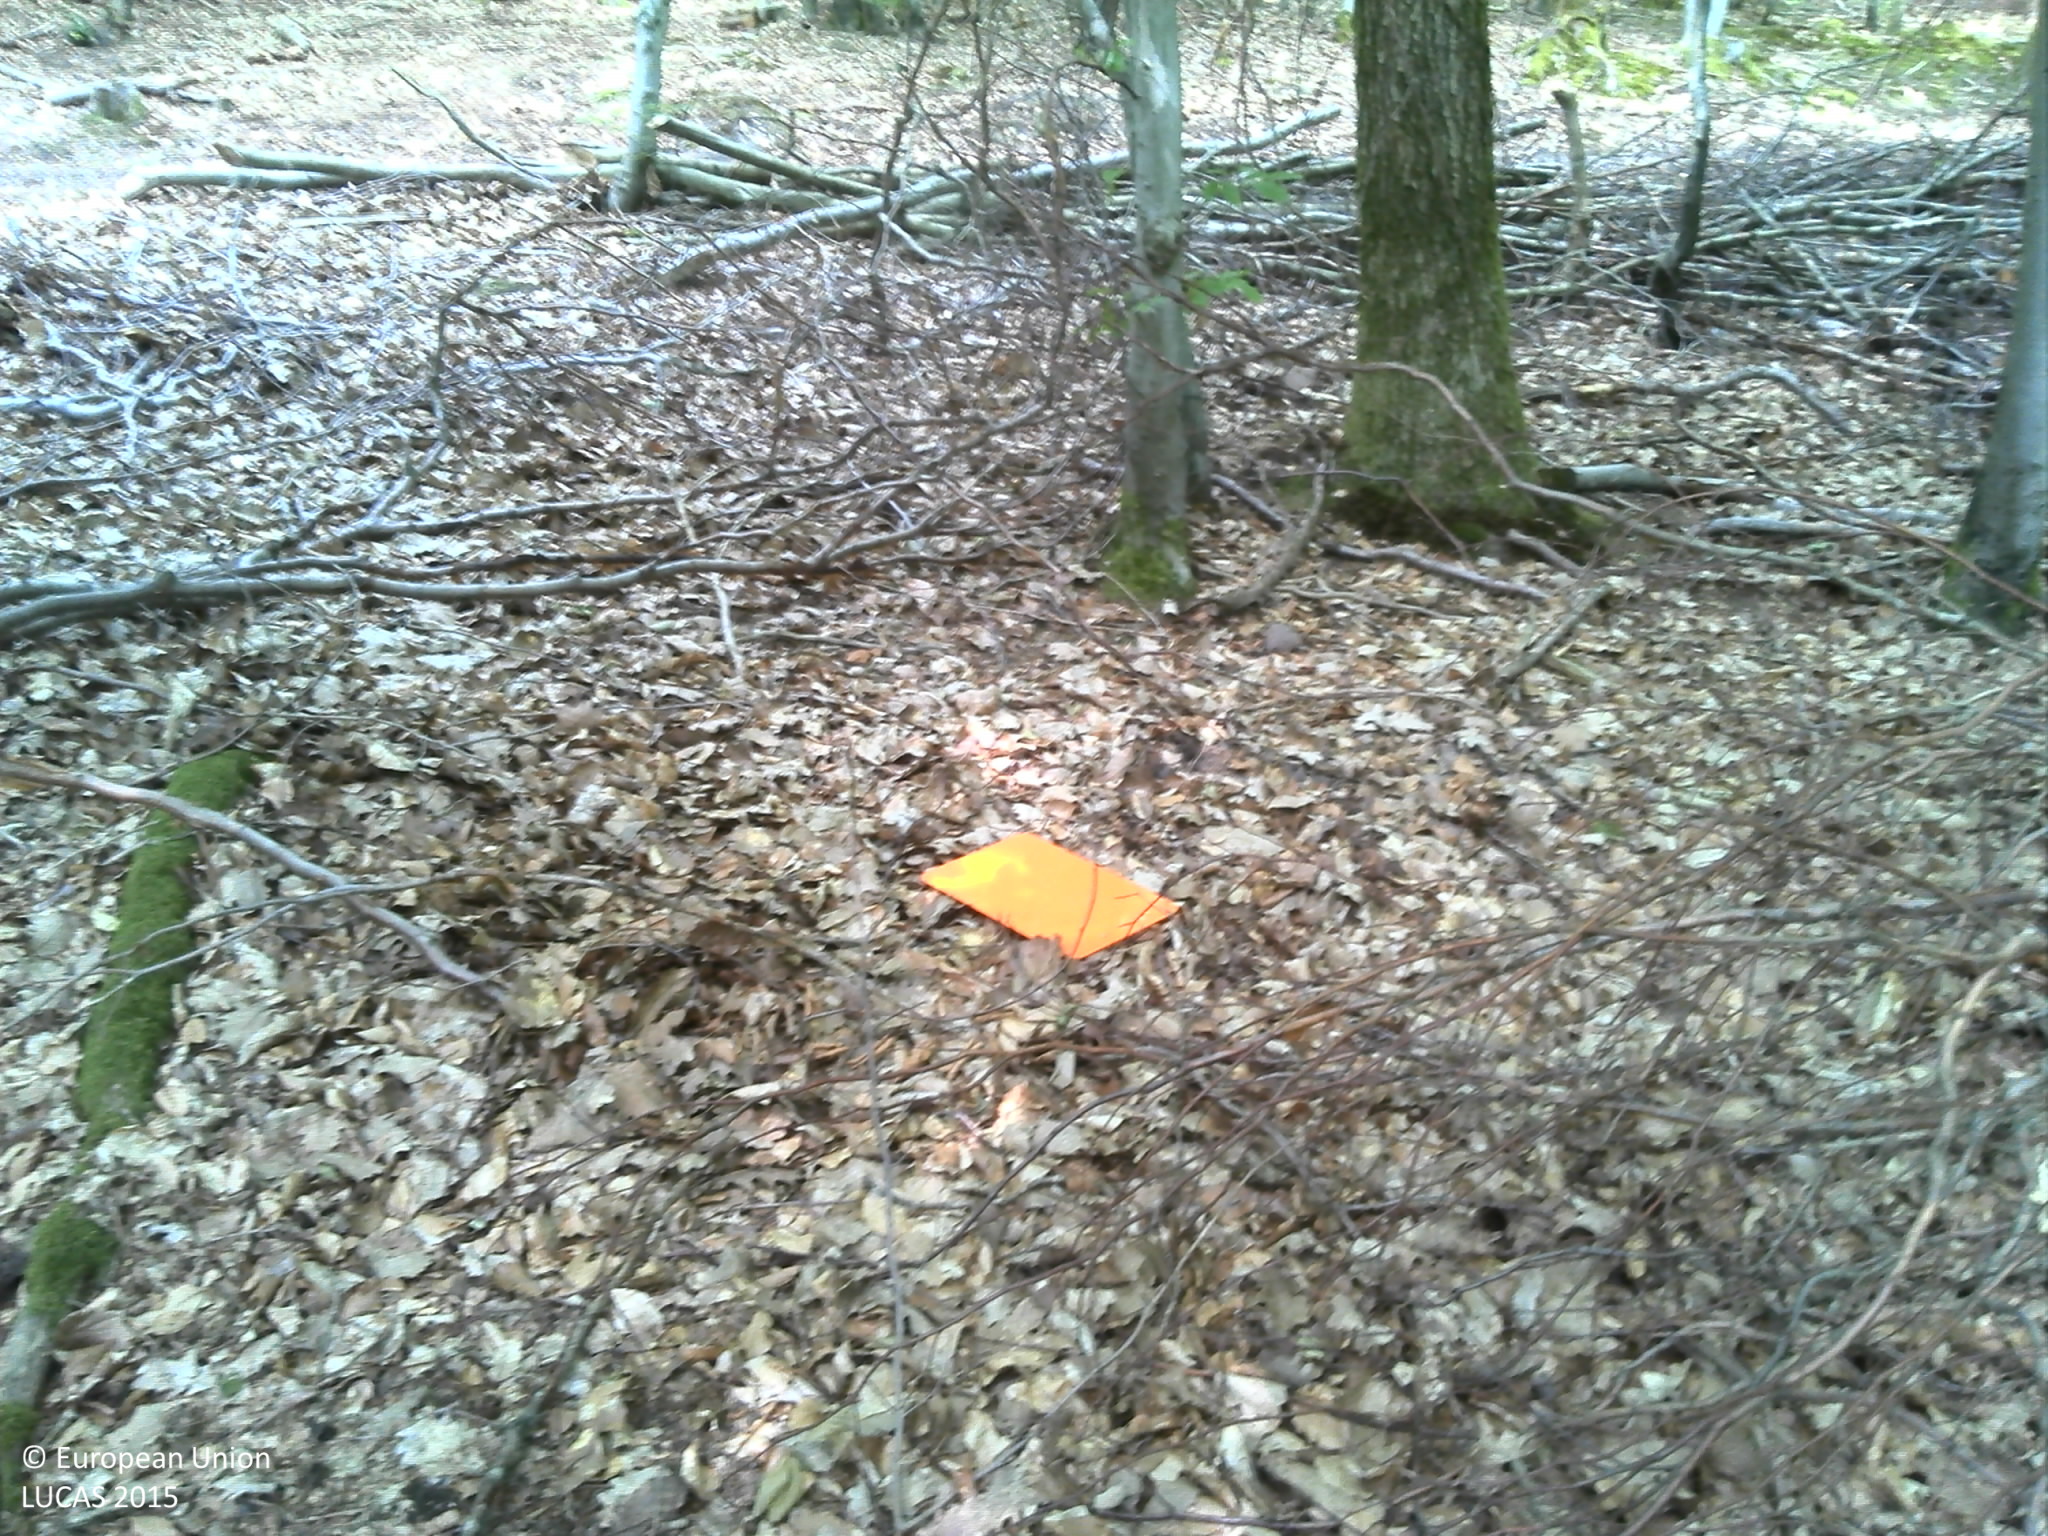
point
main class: Woodland
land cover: Broadleaved woodland
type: acidophilous oak and oak-birch forest
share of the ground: > 75 %
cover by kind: broadleaved forest trees 95 %, unconsolidated bare surface 5 %
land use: Forestry
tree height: > 5 m
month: July
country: FR
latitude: 49.0939
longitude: 7.4396
